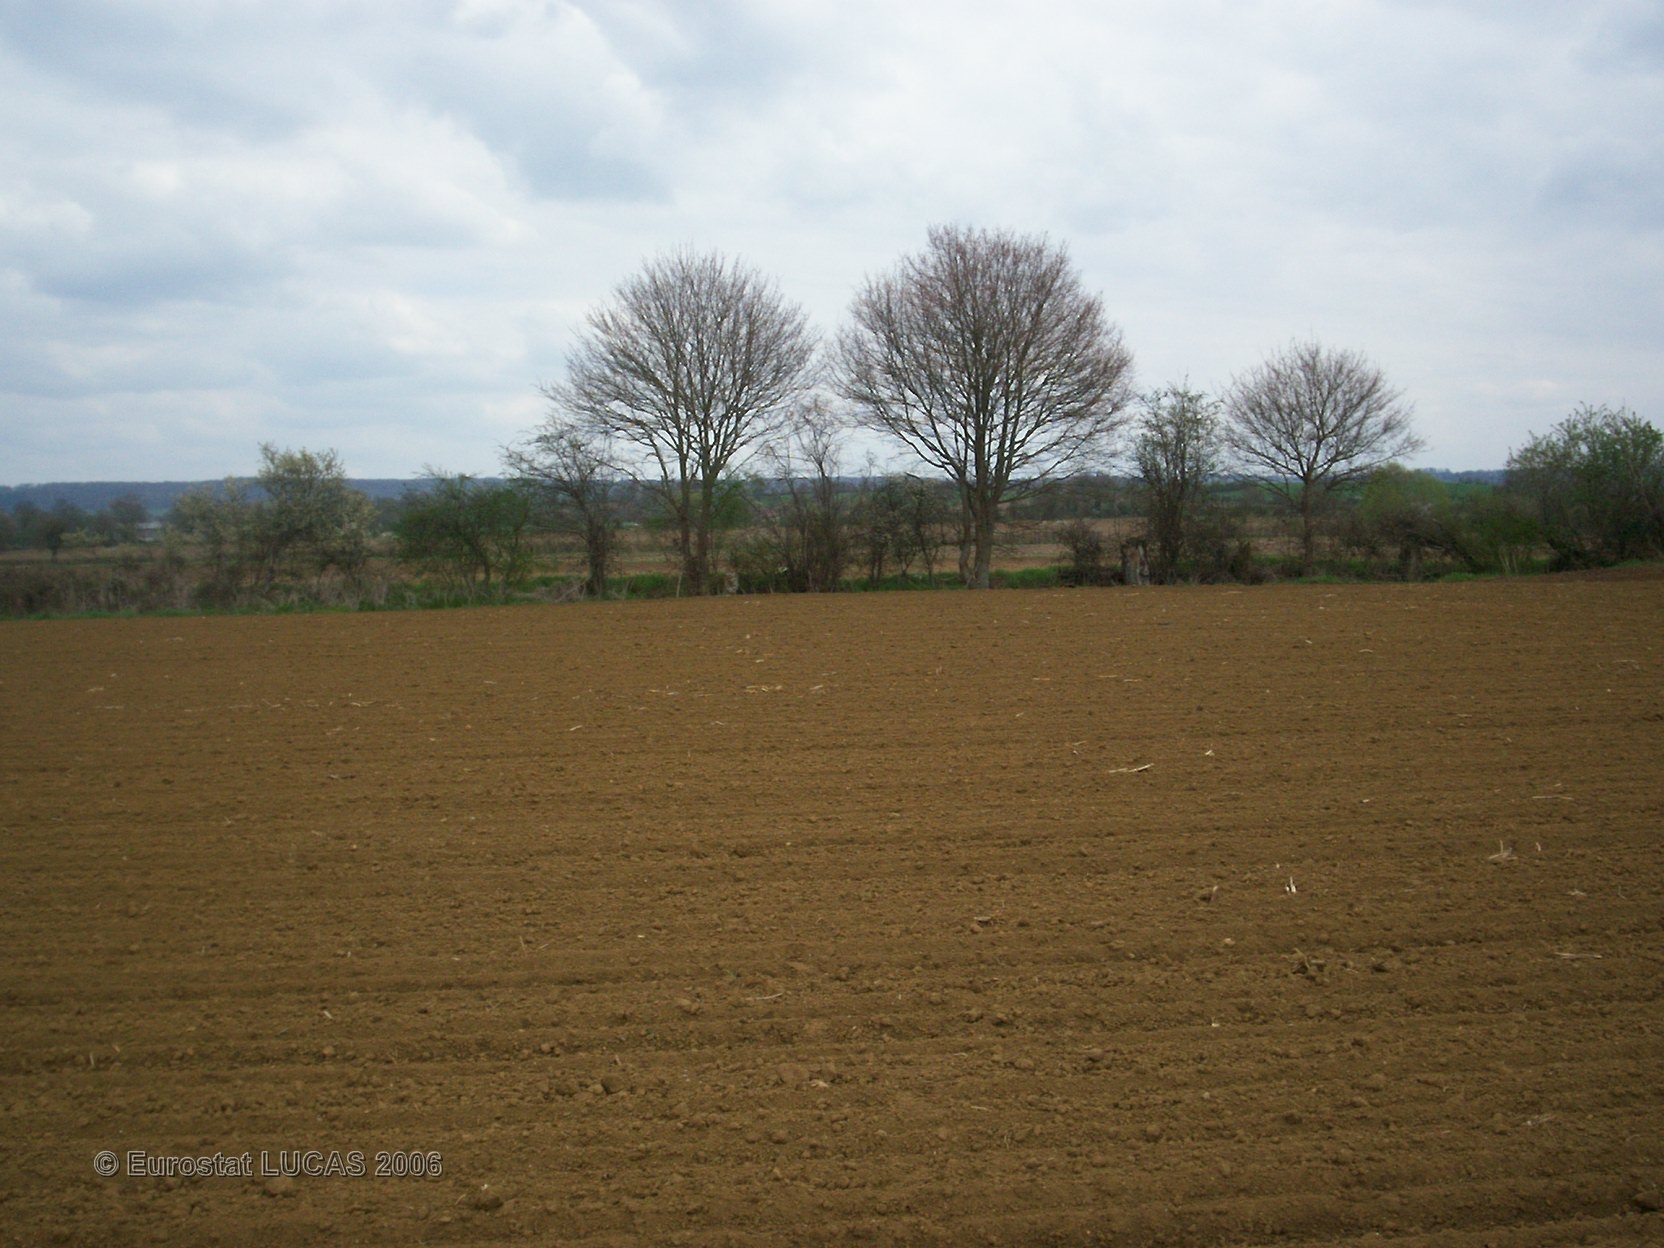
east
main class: Cropland
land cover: Sugar beet
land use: Agriculture (excluding fallow land and kitchen gardens)
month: April
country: FR
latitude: 48.9653
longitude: 0.0118
